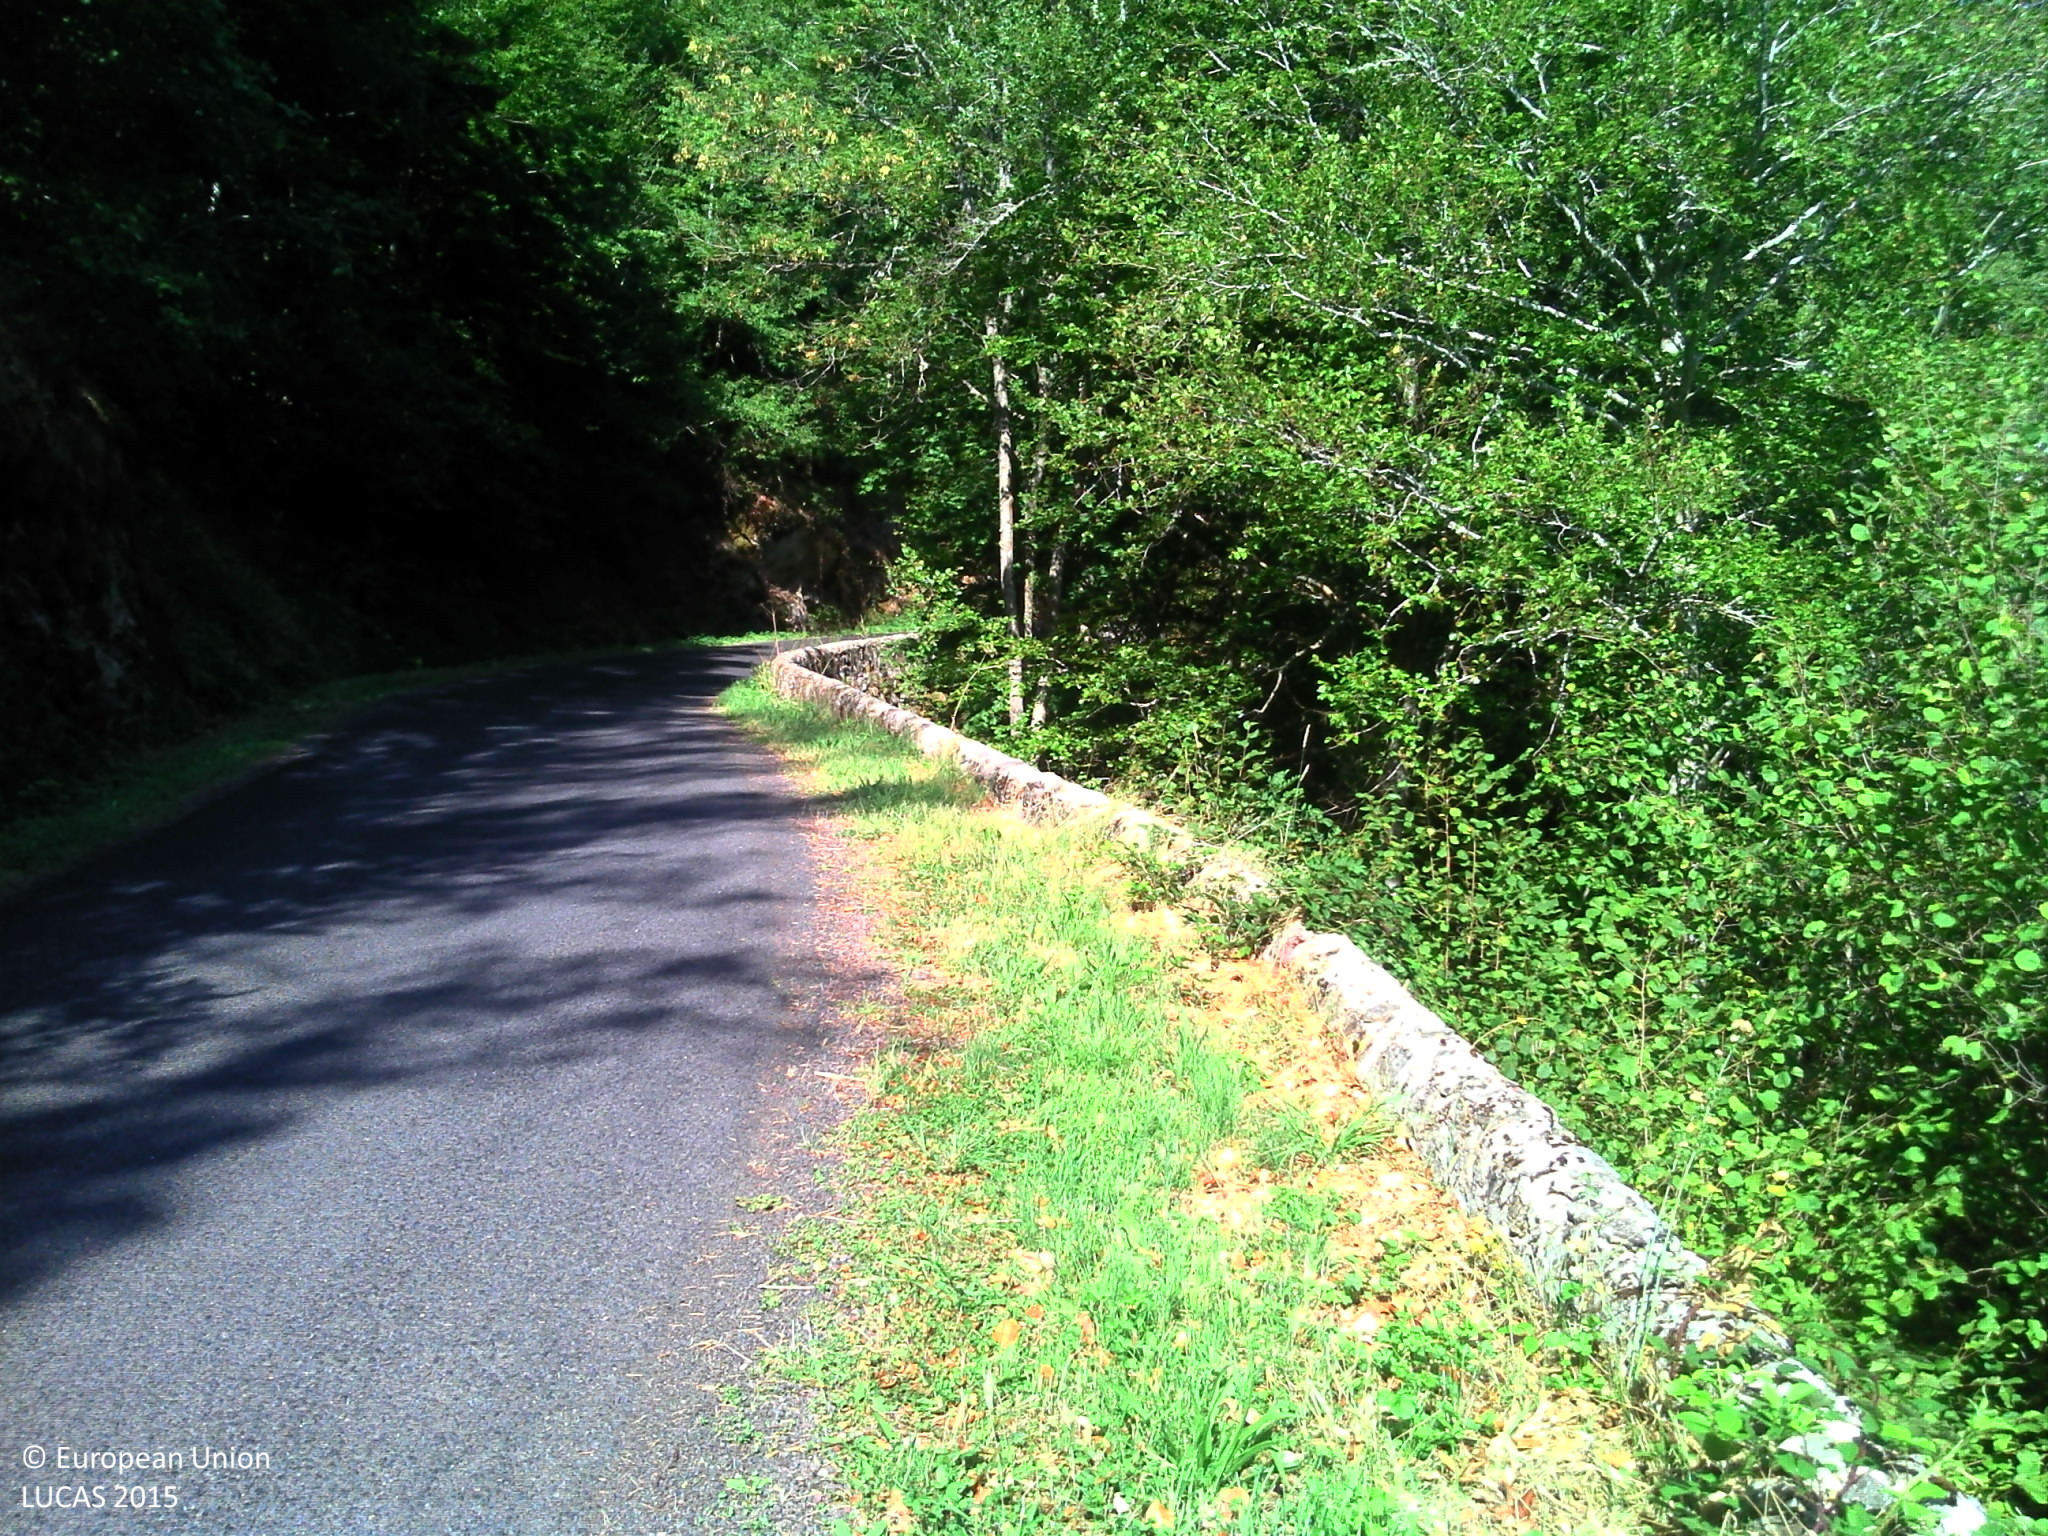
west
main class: Woodland
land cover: Broadleaved woodland
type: acidophilous oak and oak-birch forest
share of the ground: > 75 %
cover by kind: broadleaved forest trees 80 %, coniferous forest trees 10 %, shrubs 10 %
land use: Forestry
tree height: > 5 m
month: August
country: FR
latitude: 45.2168
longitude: 3.8530
